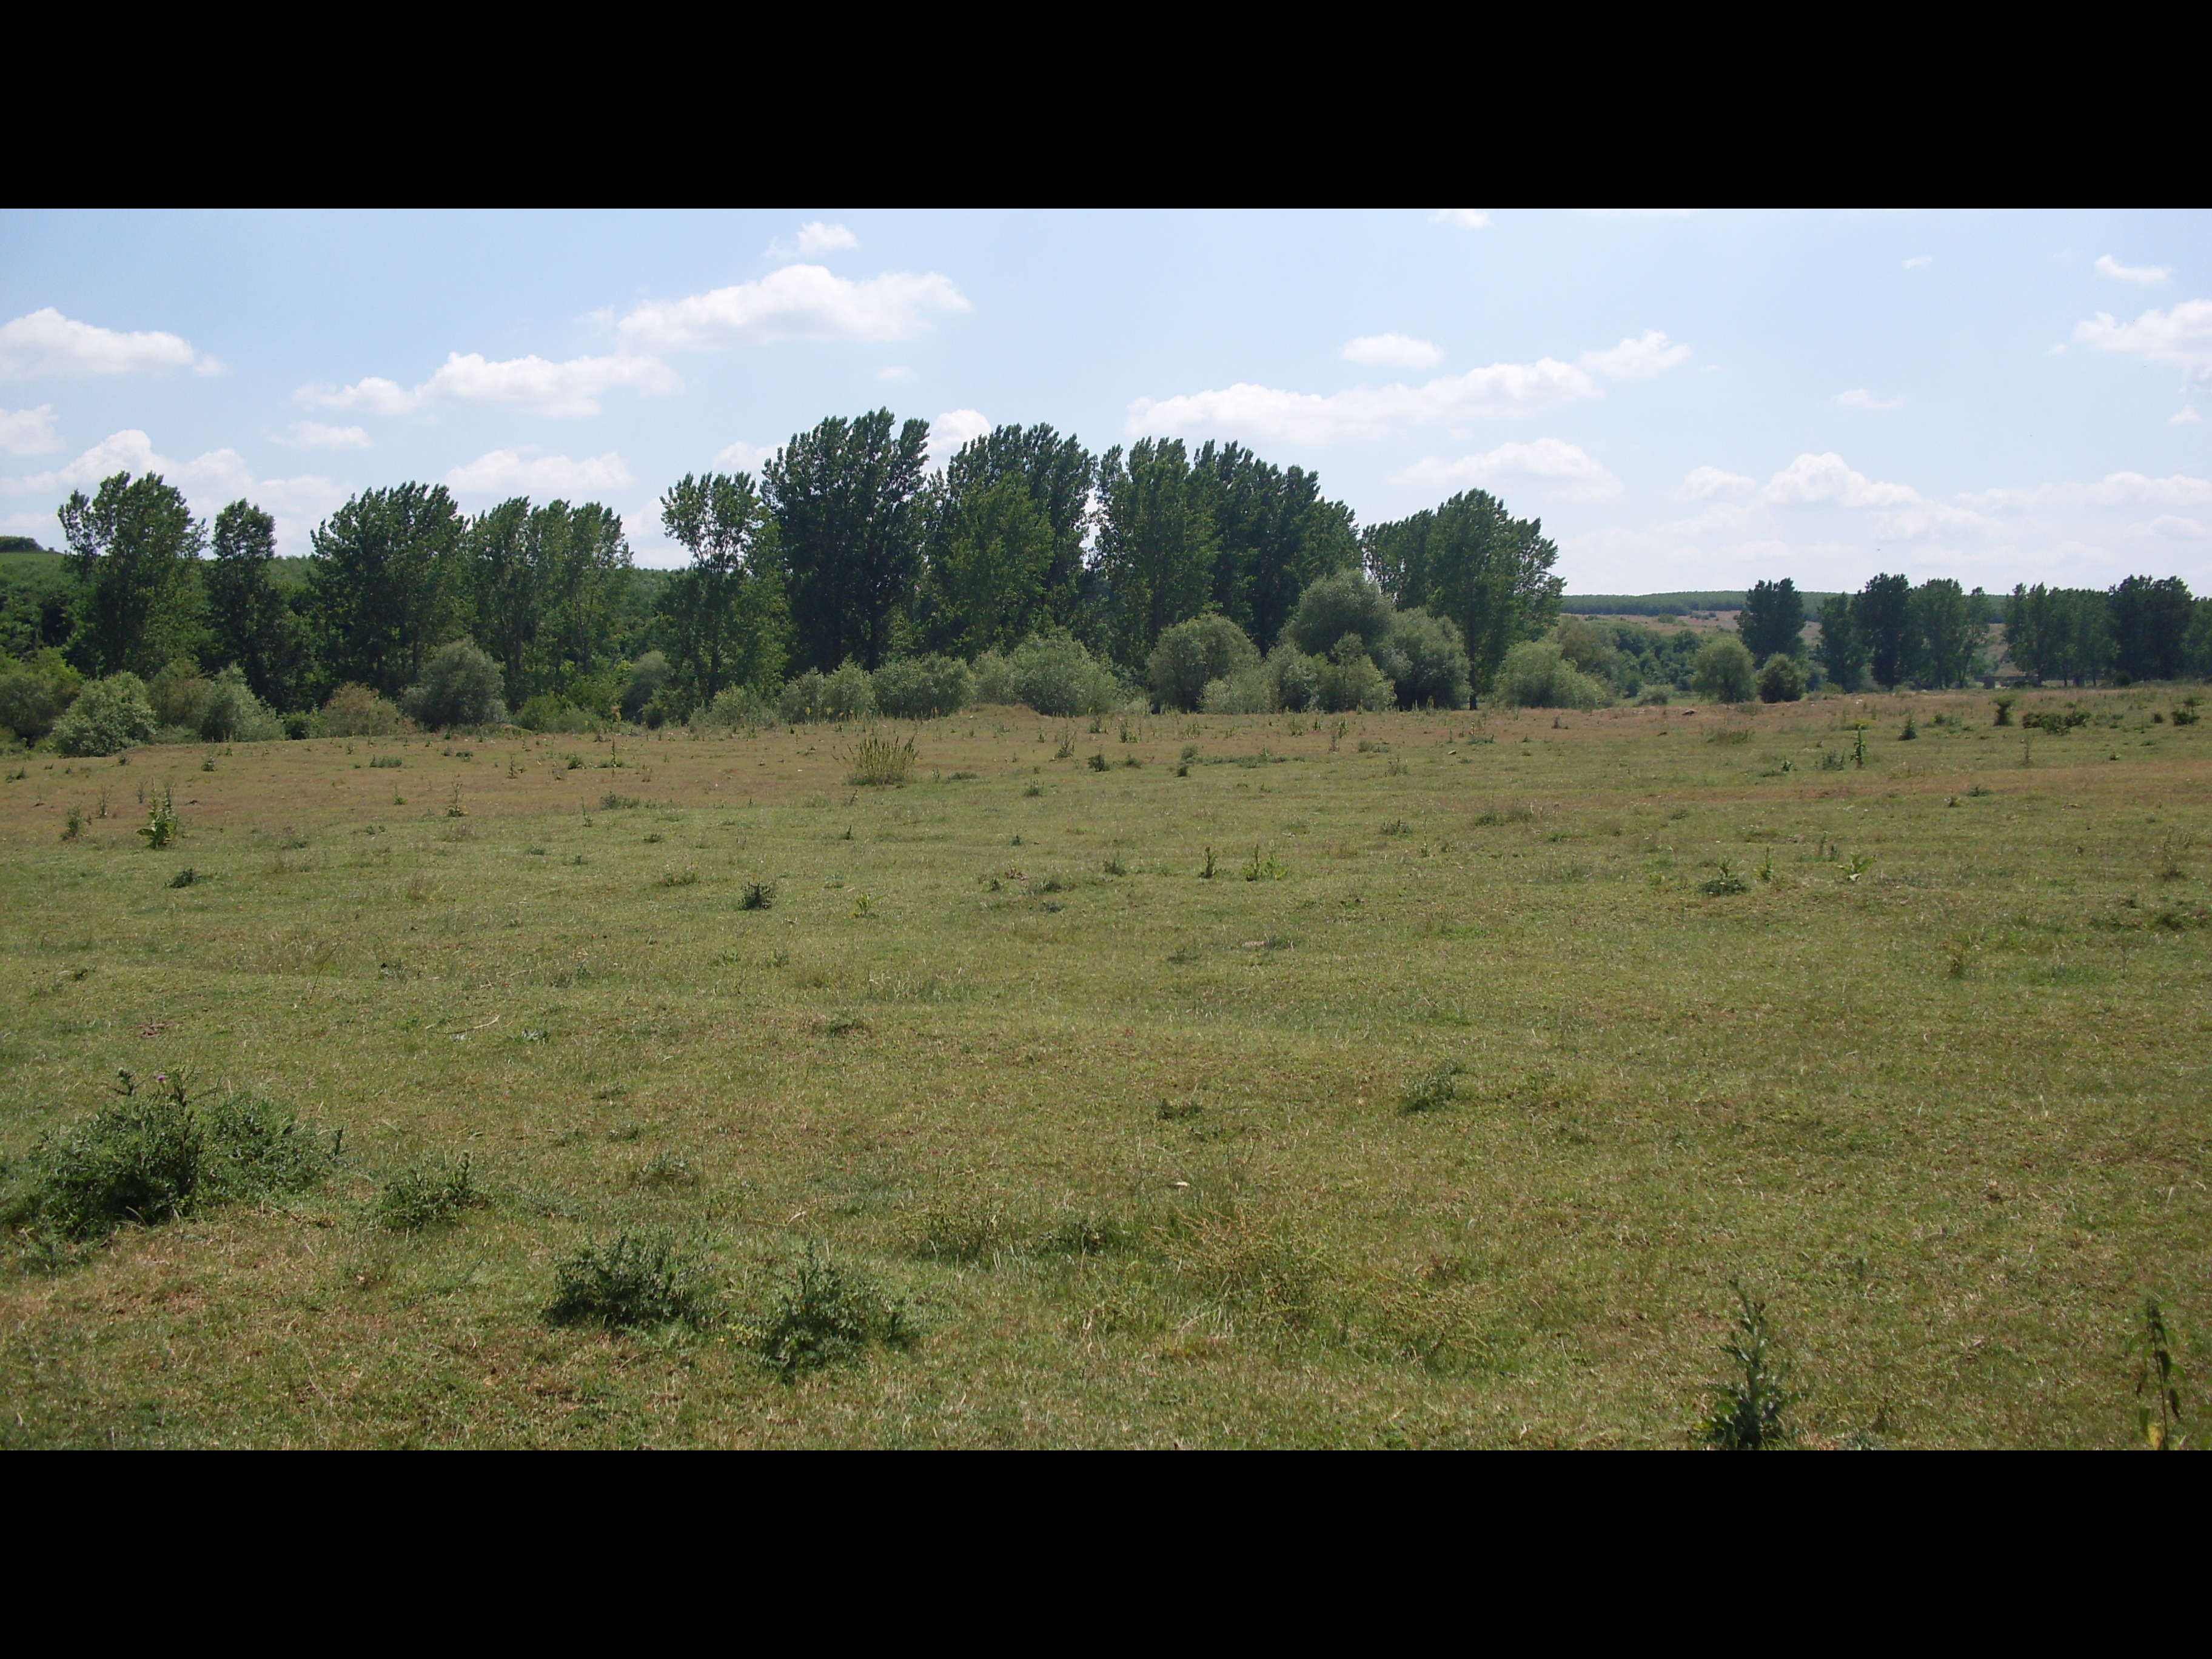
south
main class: Grassland
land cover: Grassland with sparse tree/shrub cover
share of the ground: > 75 %
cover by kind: herbaceous plants 90 %, broadleaved forest trees 5 %, shrubs 5 %
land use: Agriculture (excluding fallow land and kitchen gardens)
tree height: < 5 m
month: June
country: BG
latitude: 43.5308
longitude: 23.5454
